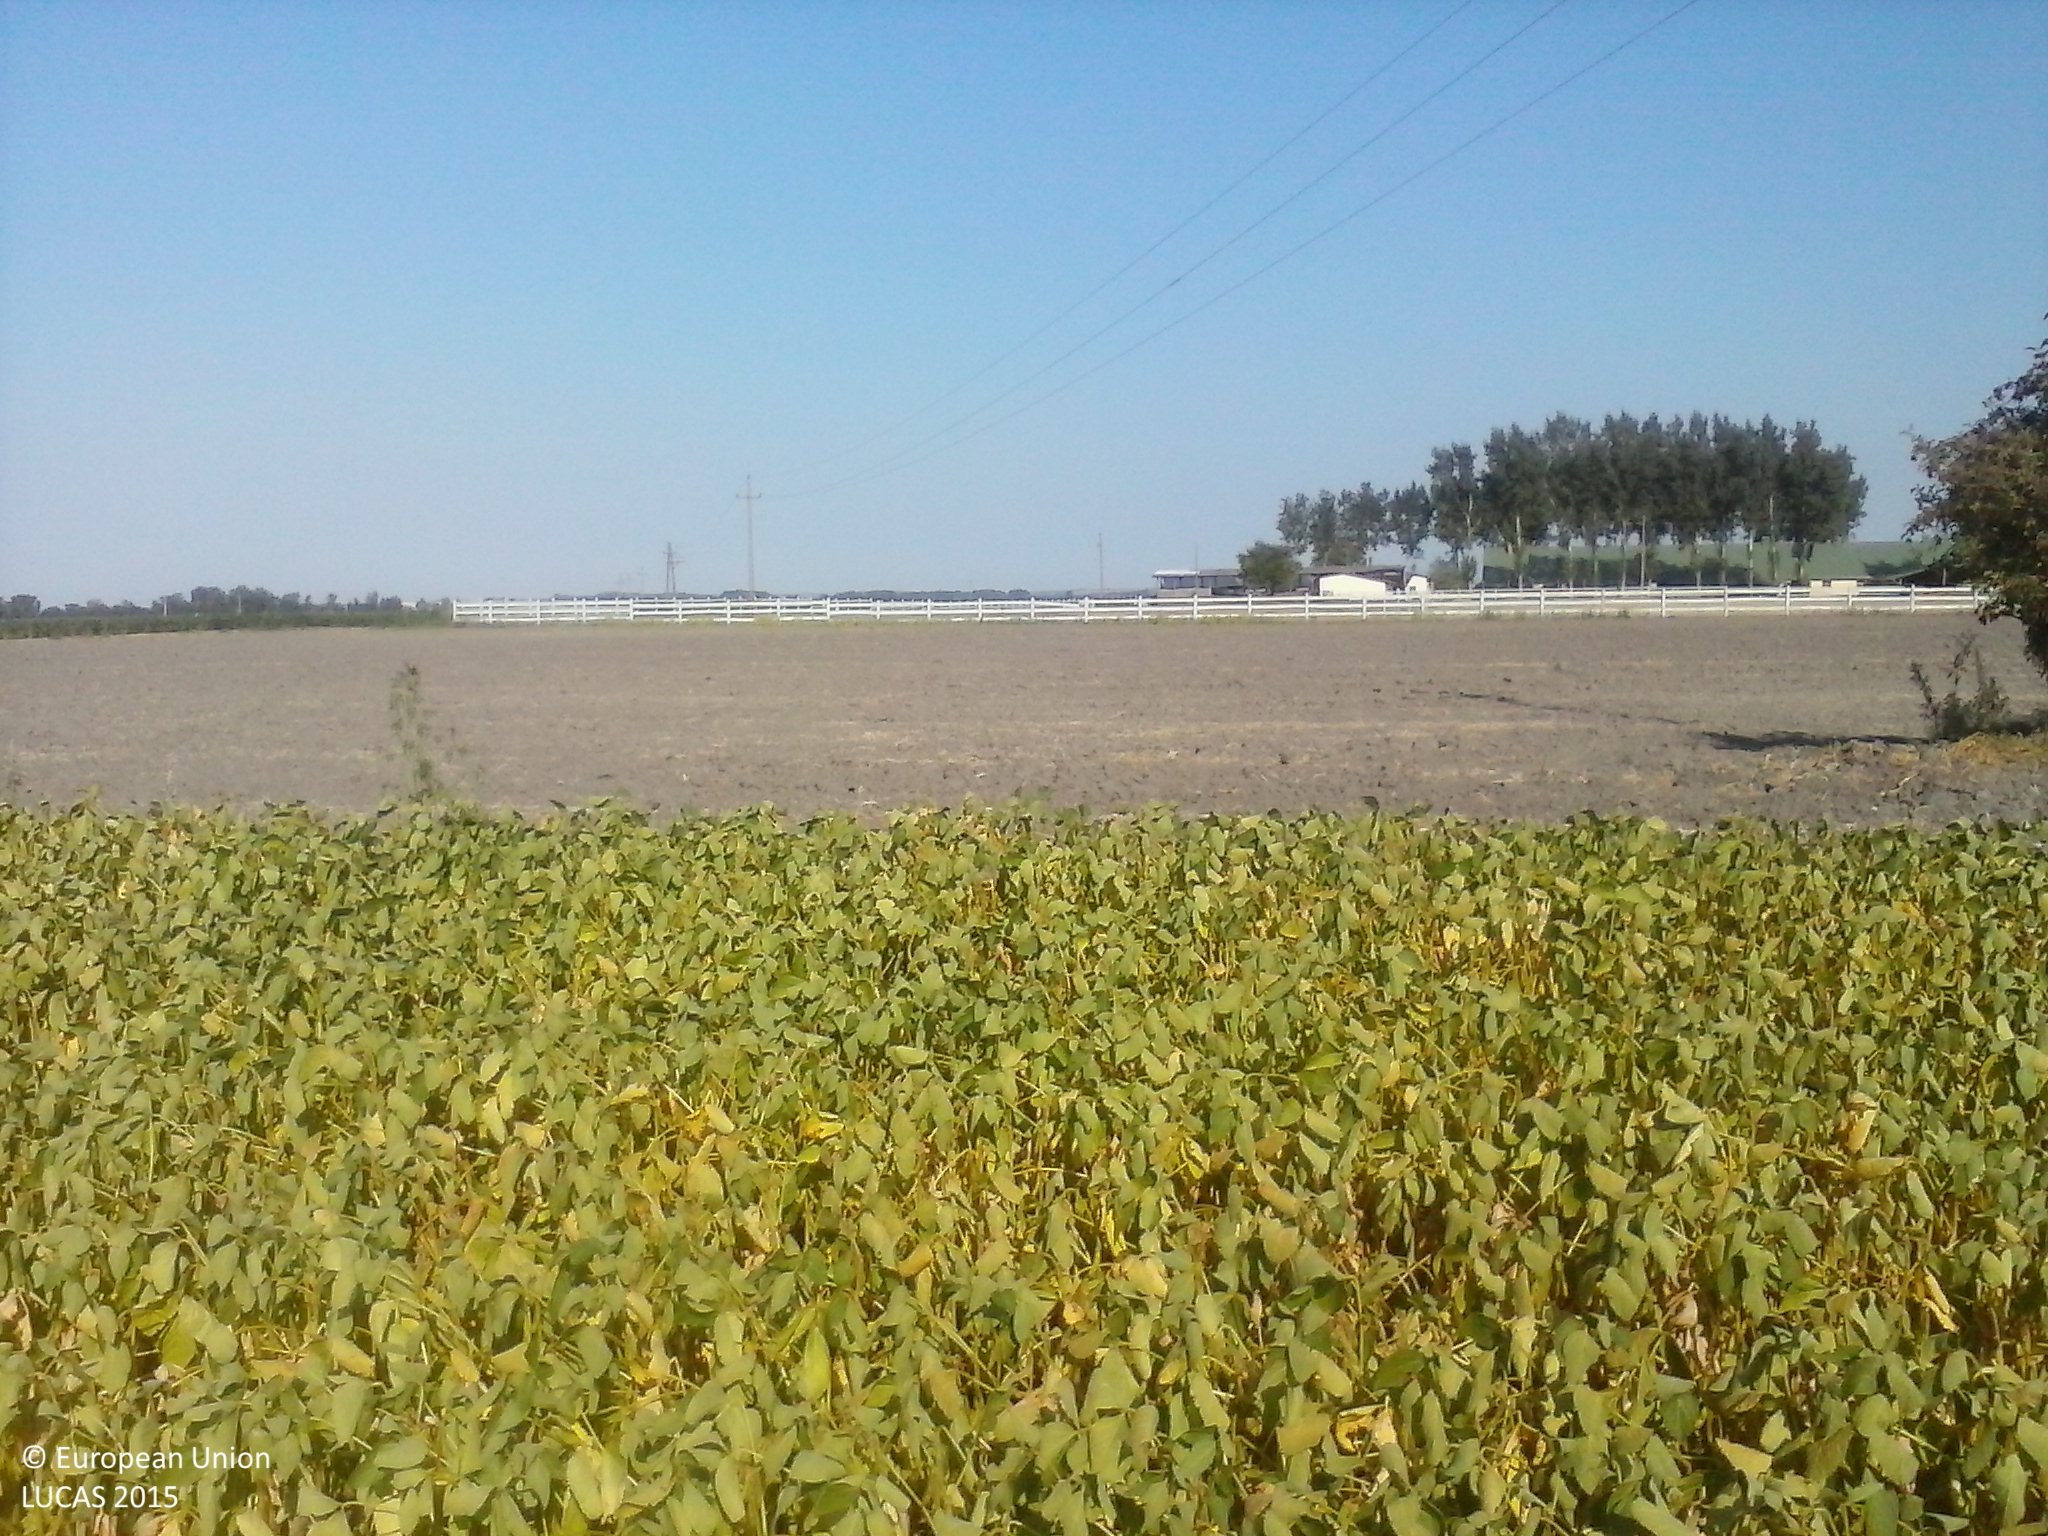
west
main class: Cropland
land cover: Soya
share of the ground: > 75 %
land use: Agriculture (excluding fallow land and kitchen gardens)
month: July
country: HU
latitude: 46.0193
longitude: 18.8588
